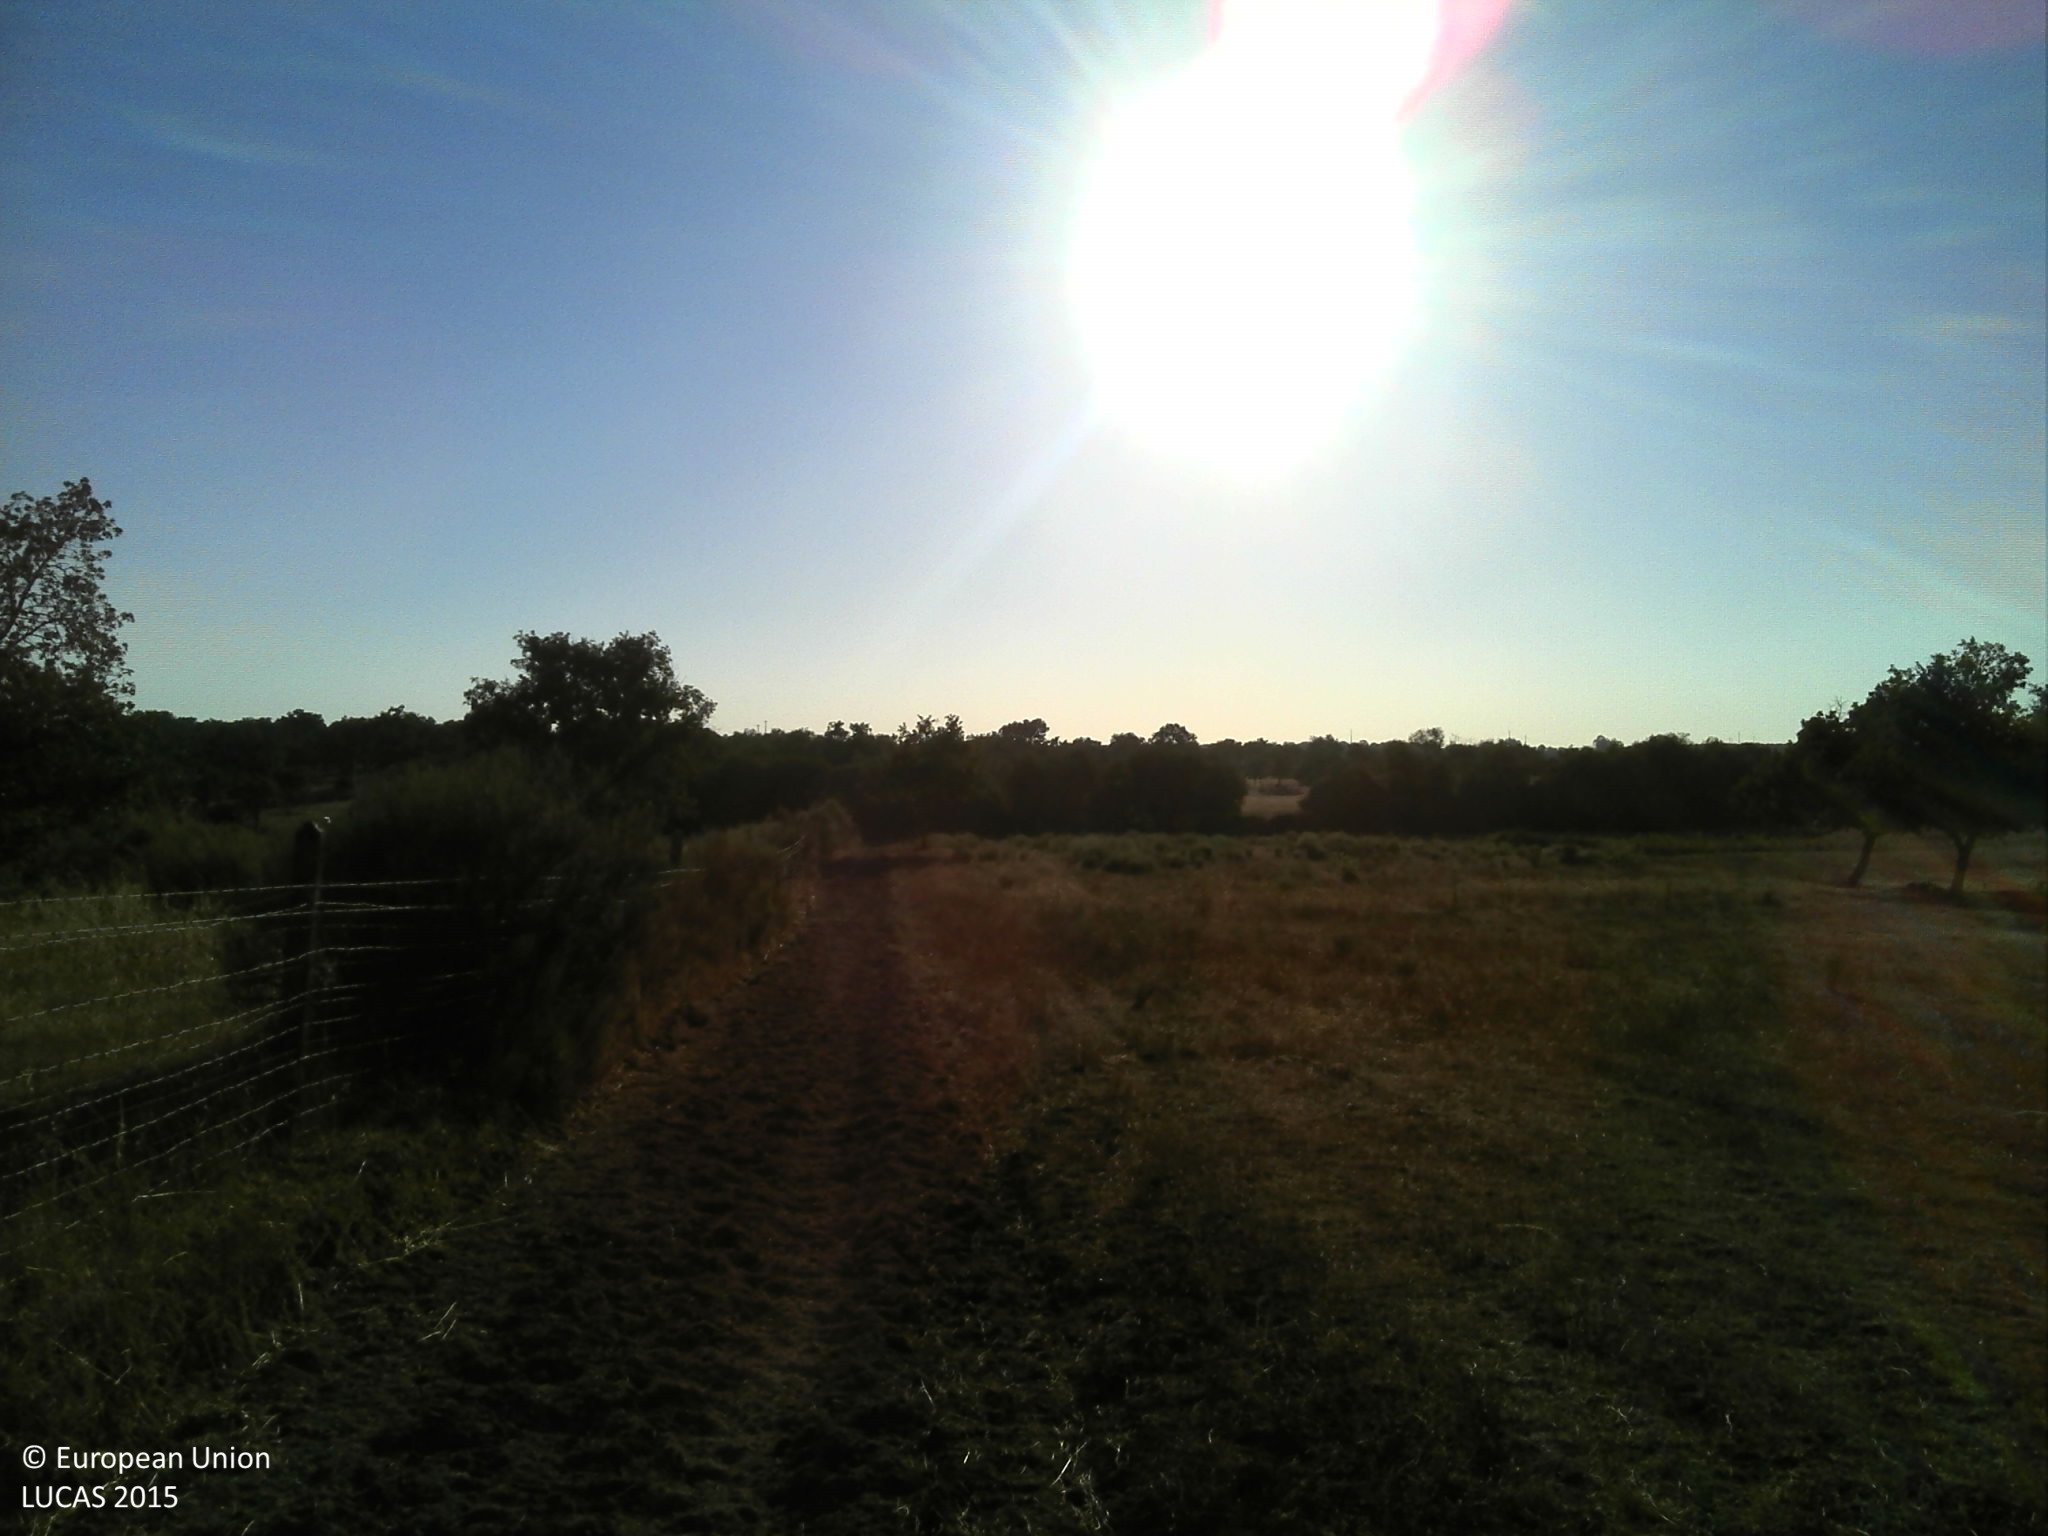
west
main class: Grassland
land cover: Grassland without tree/shrub cover
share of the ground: 25 - 50 %
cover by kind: unconsolidated bare surface 70 %, herbaceous plants 30 %
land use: Agriculture (excluding fallow land and kitchen gardens)
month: August
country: PT
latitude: 39.4060
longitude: -7.5713
